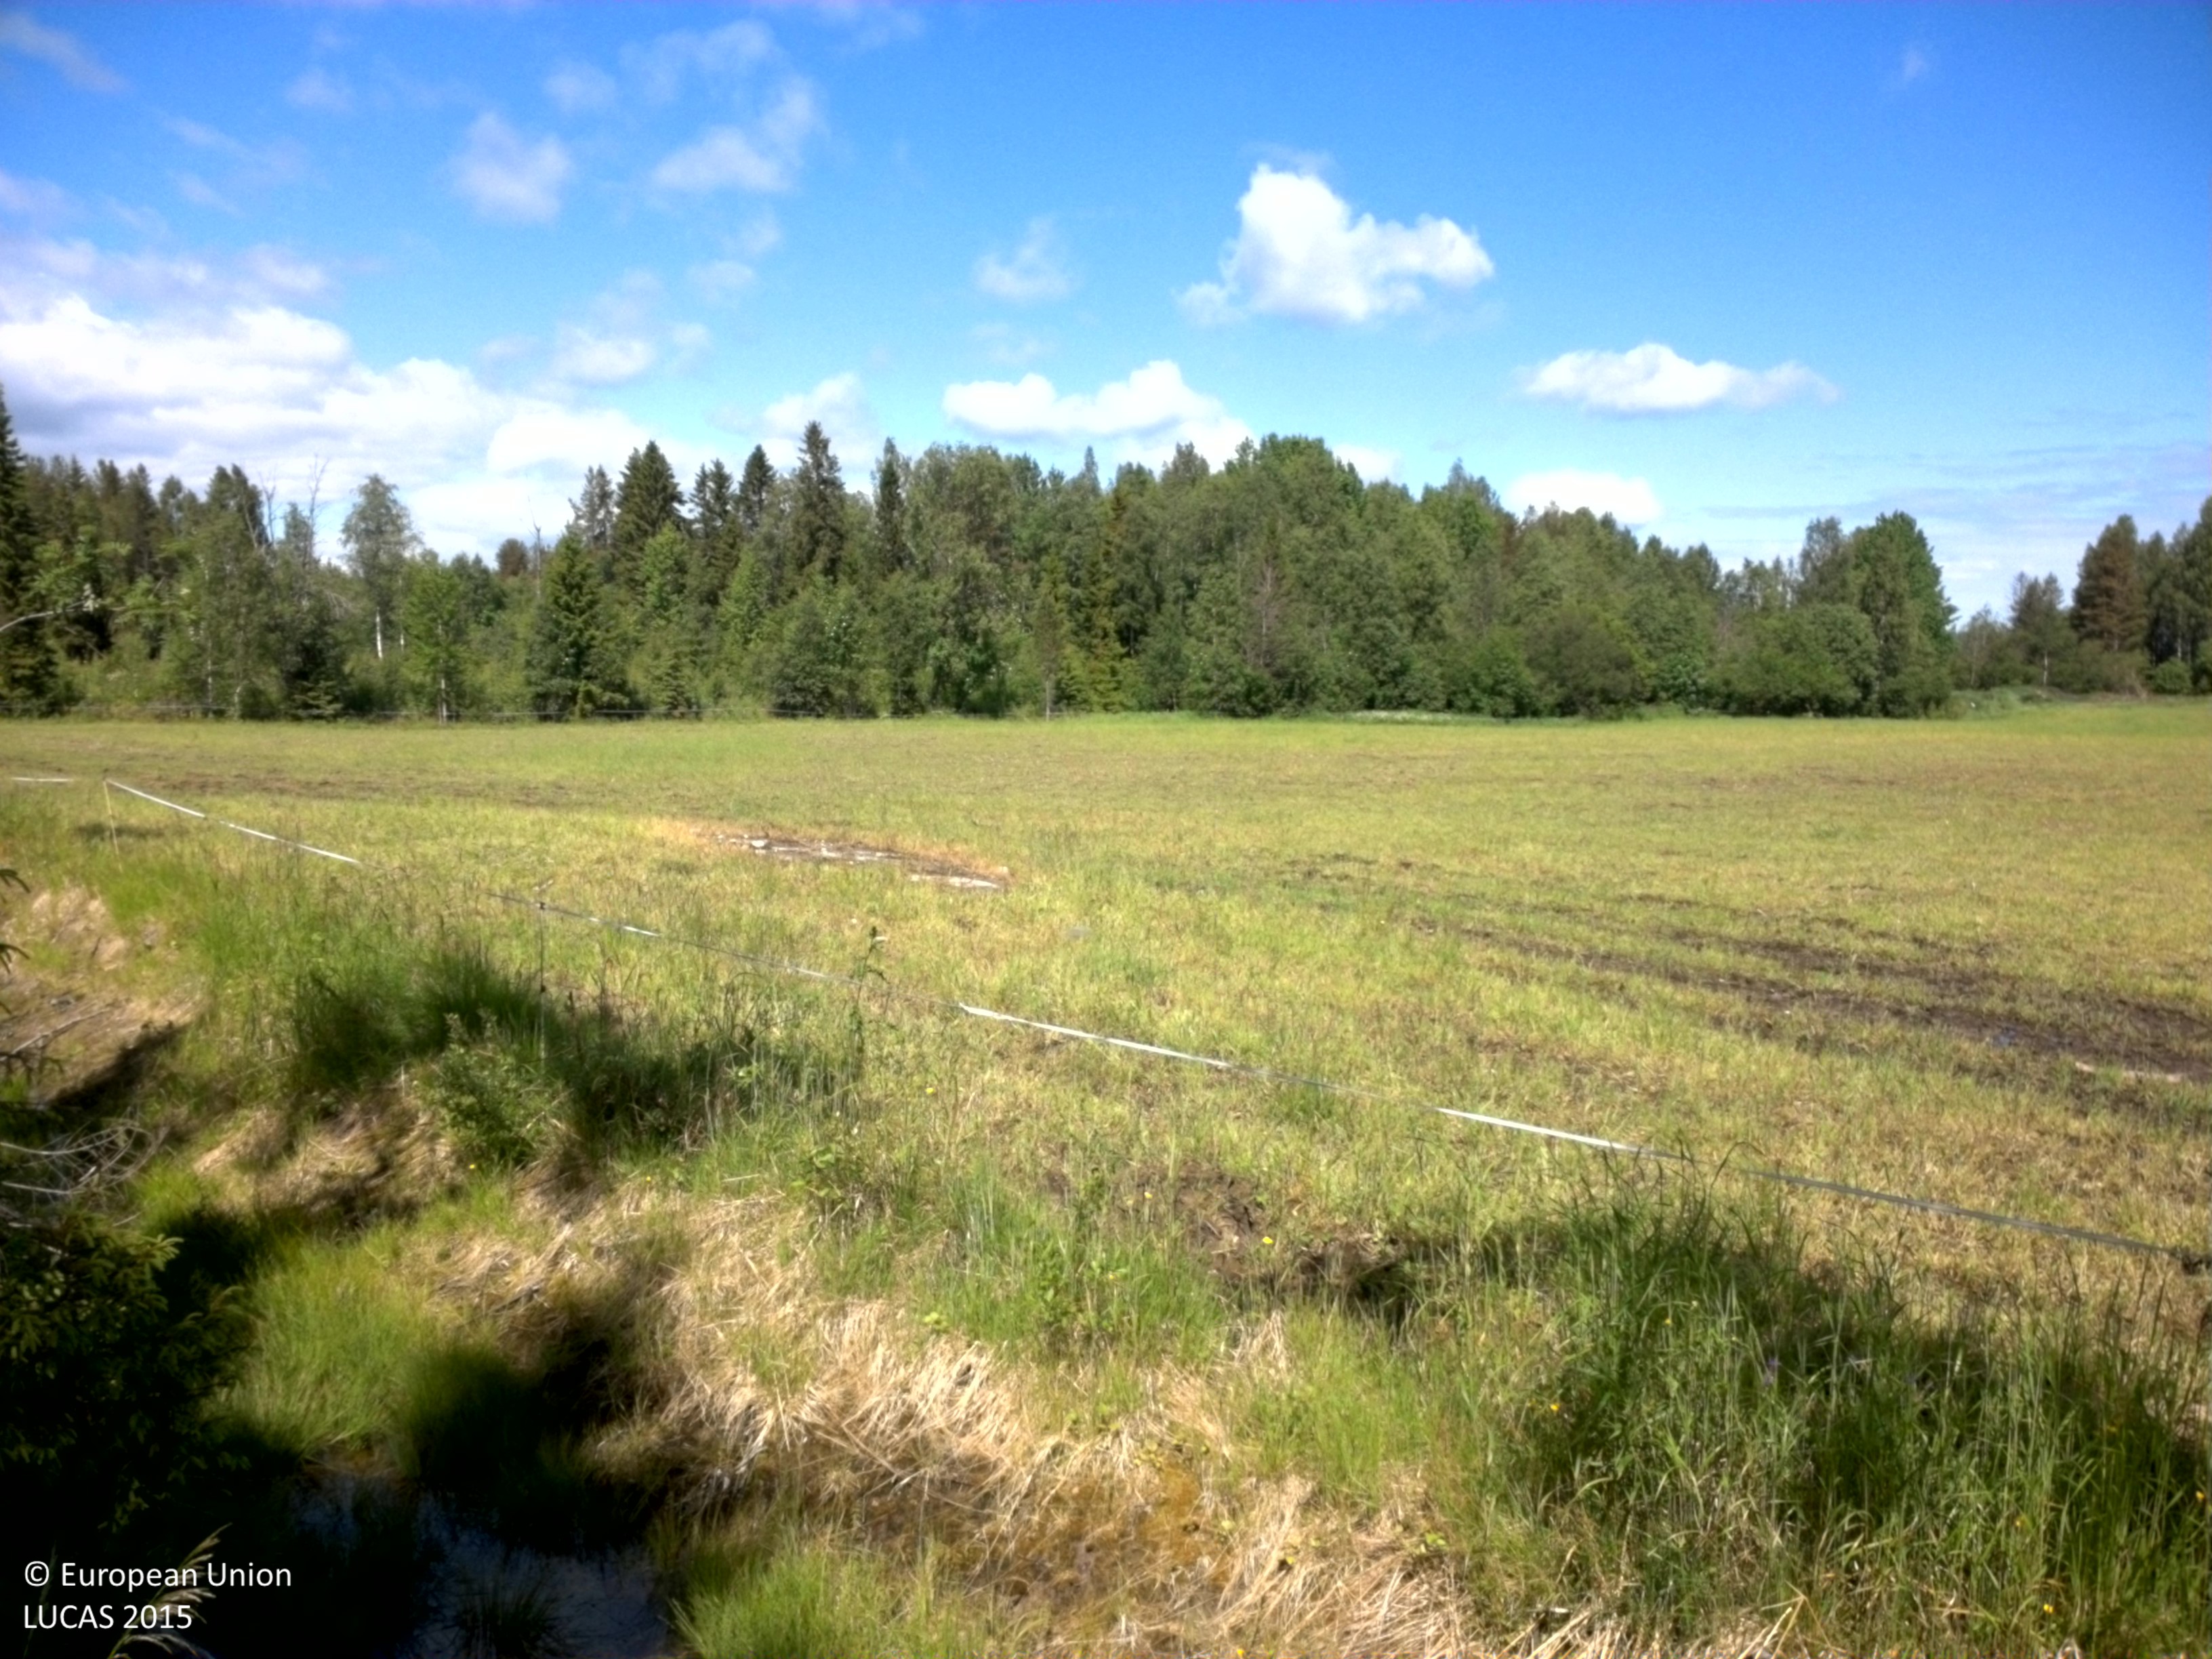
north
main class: Woodland
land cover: Spruce dominated mixed woodland
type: boreal forest
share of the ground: 50 - 75 %
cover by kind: coniferous forest trees 45 %, shrubs 30 %, broadleaved forest trees 15 %, herbaceous plants 10 %
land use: Forestry
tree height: > 5 m
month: June
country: SE
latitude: 64.2799
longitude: 20.8659
